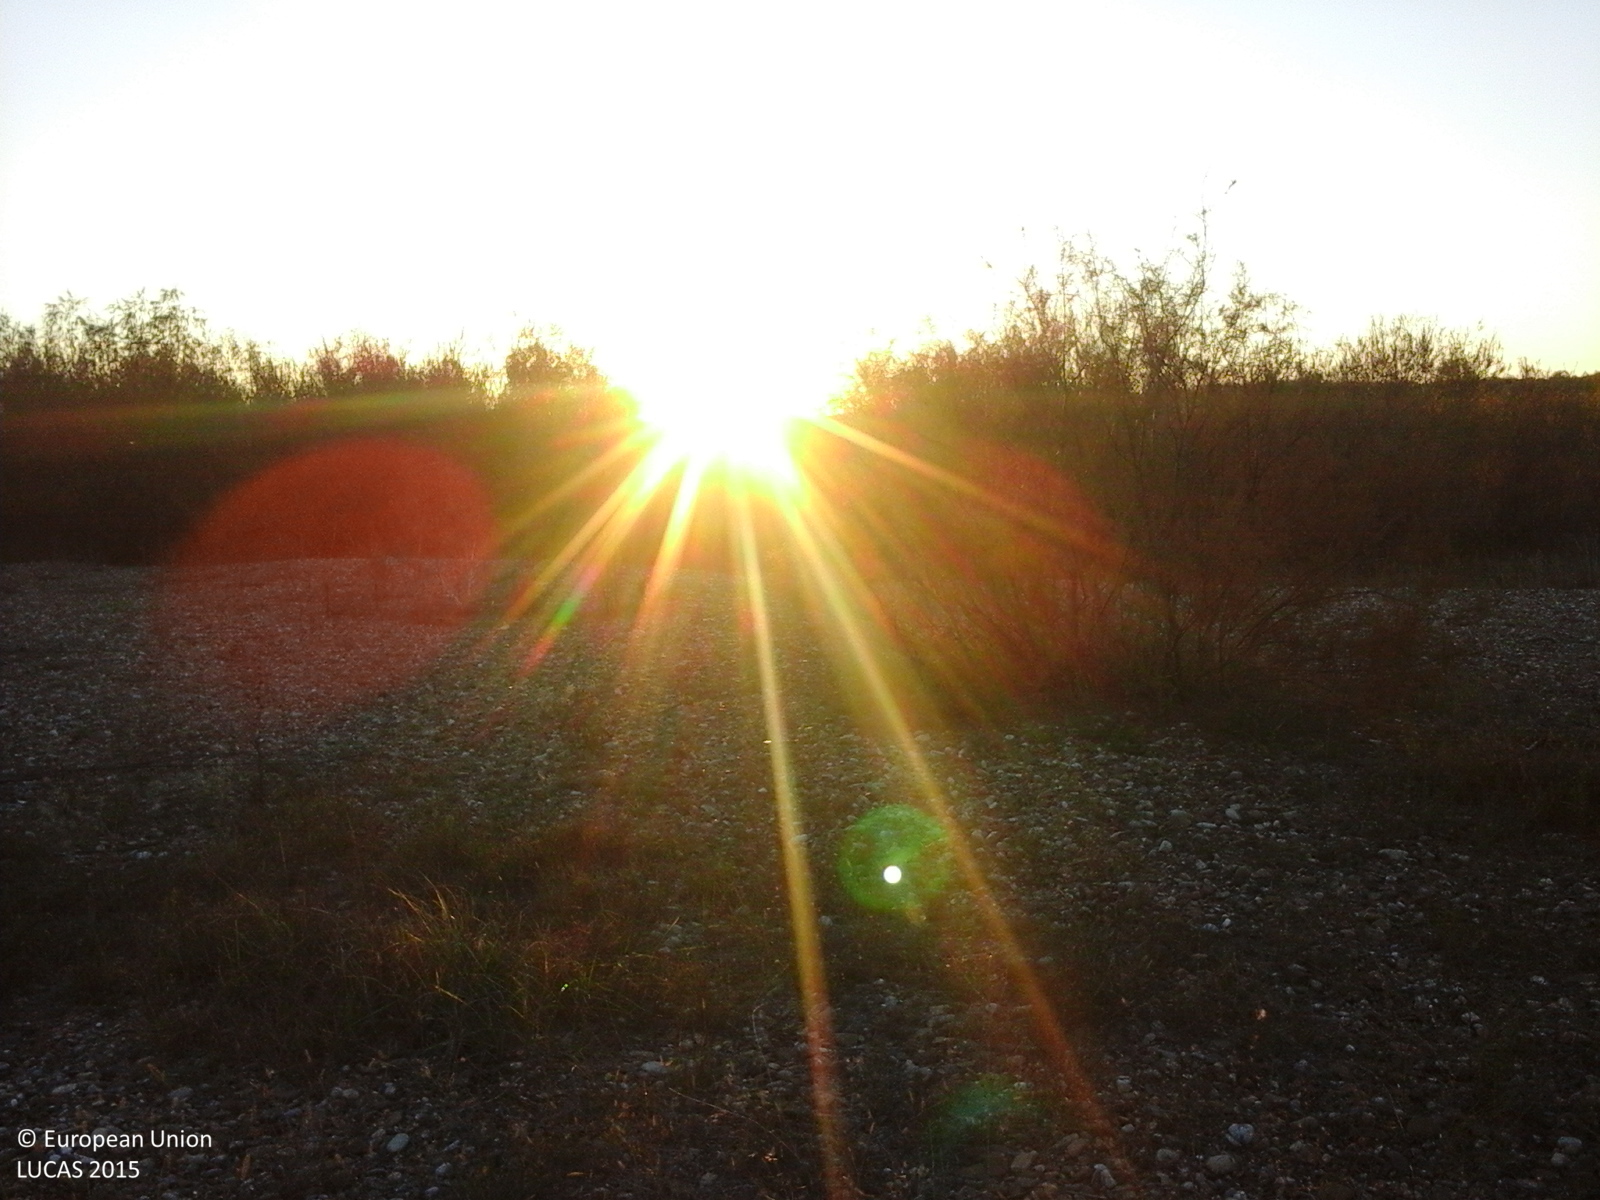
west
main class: Grassland
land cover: Spontaneously vegetated surfaces
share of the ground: 25 - 50 %
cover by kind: consolidated bare surface 75 %, herbaceous plants 25 %
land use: Semi-natural and natural areas not in use
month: October
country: RO
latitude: 46.0407
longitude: 27.2468
